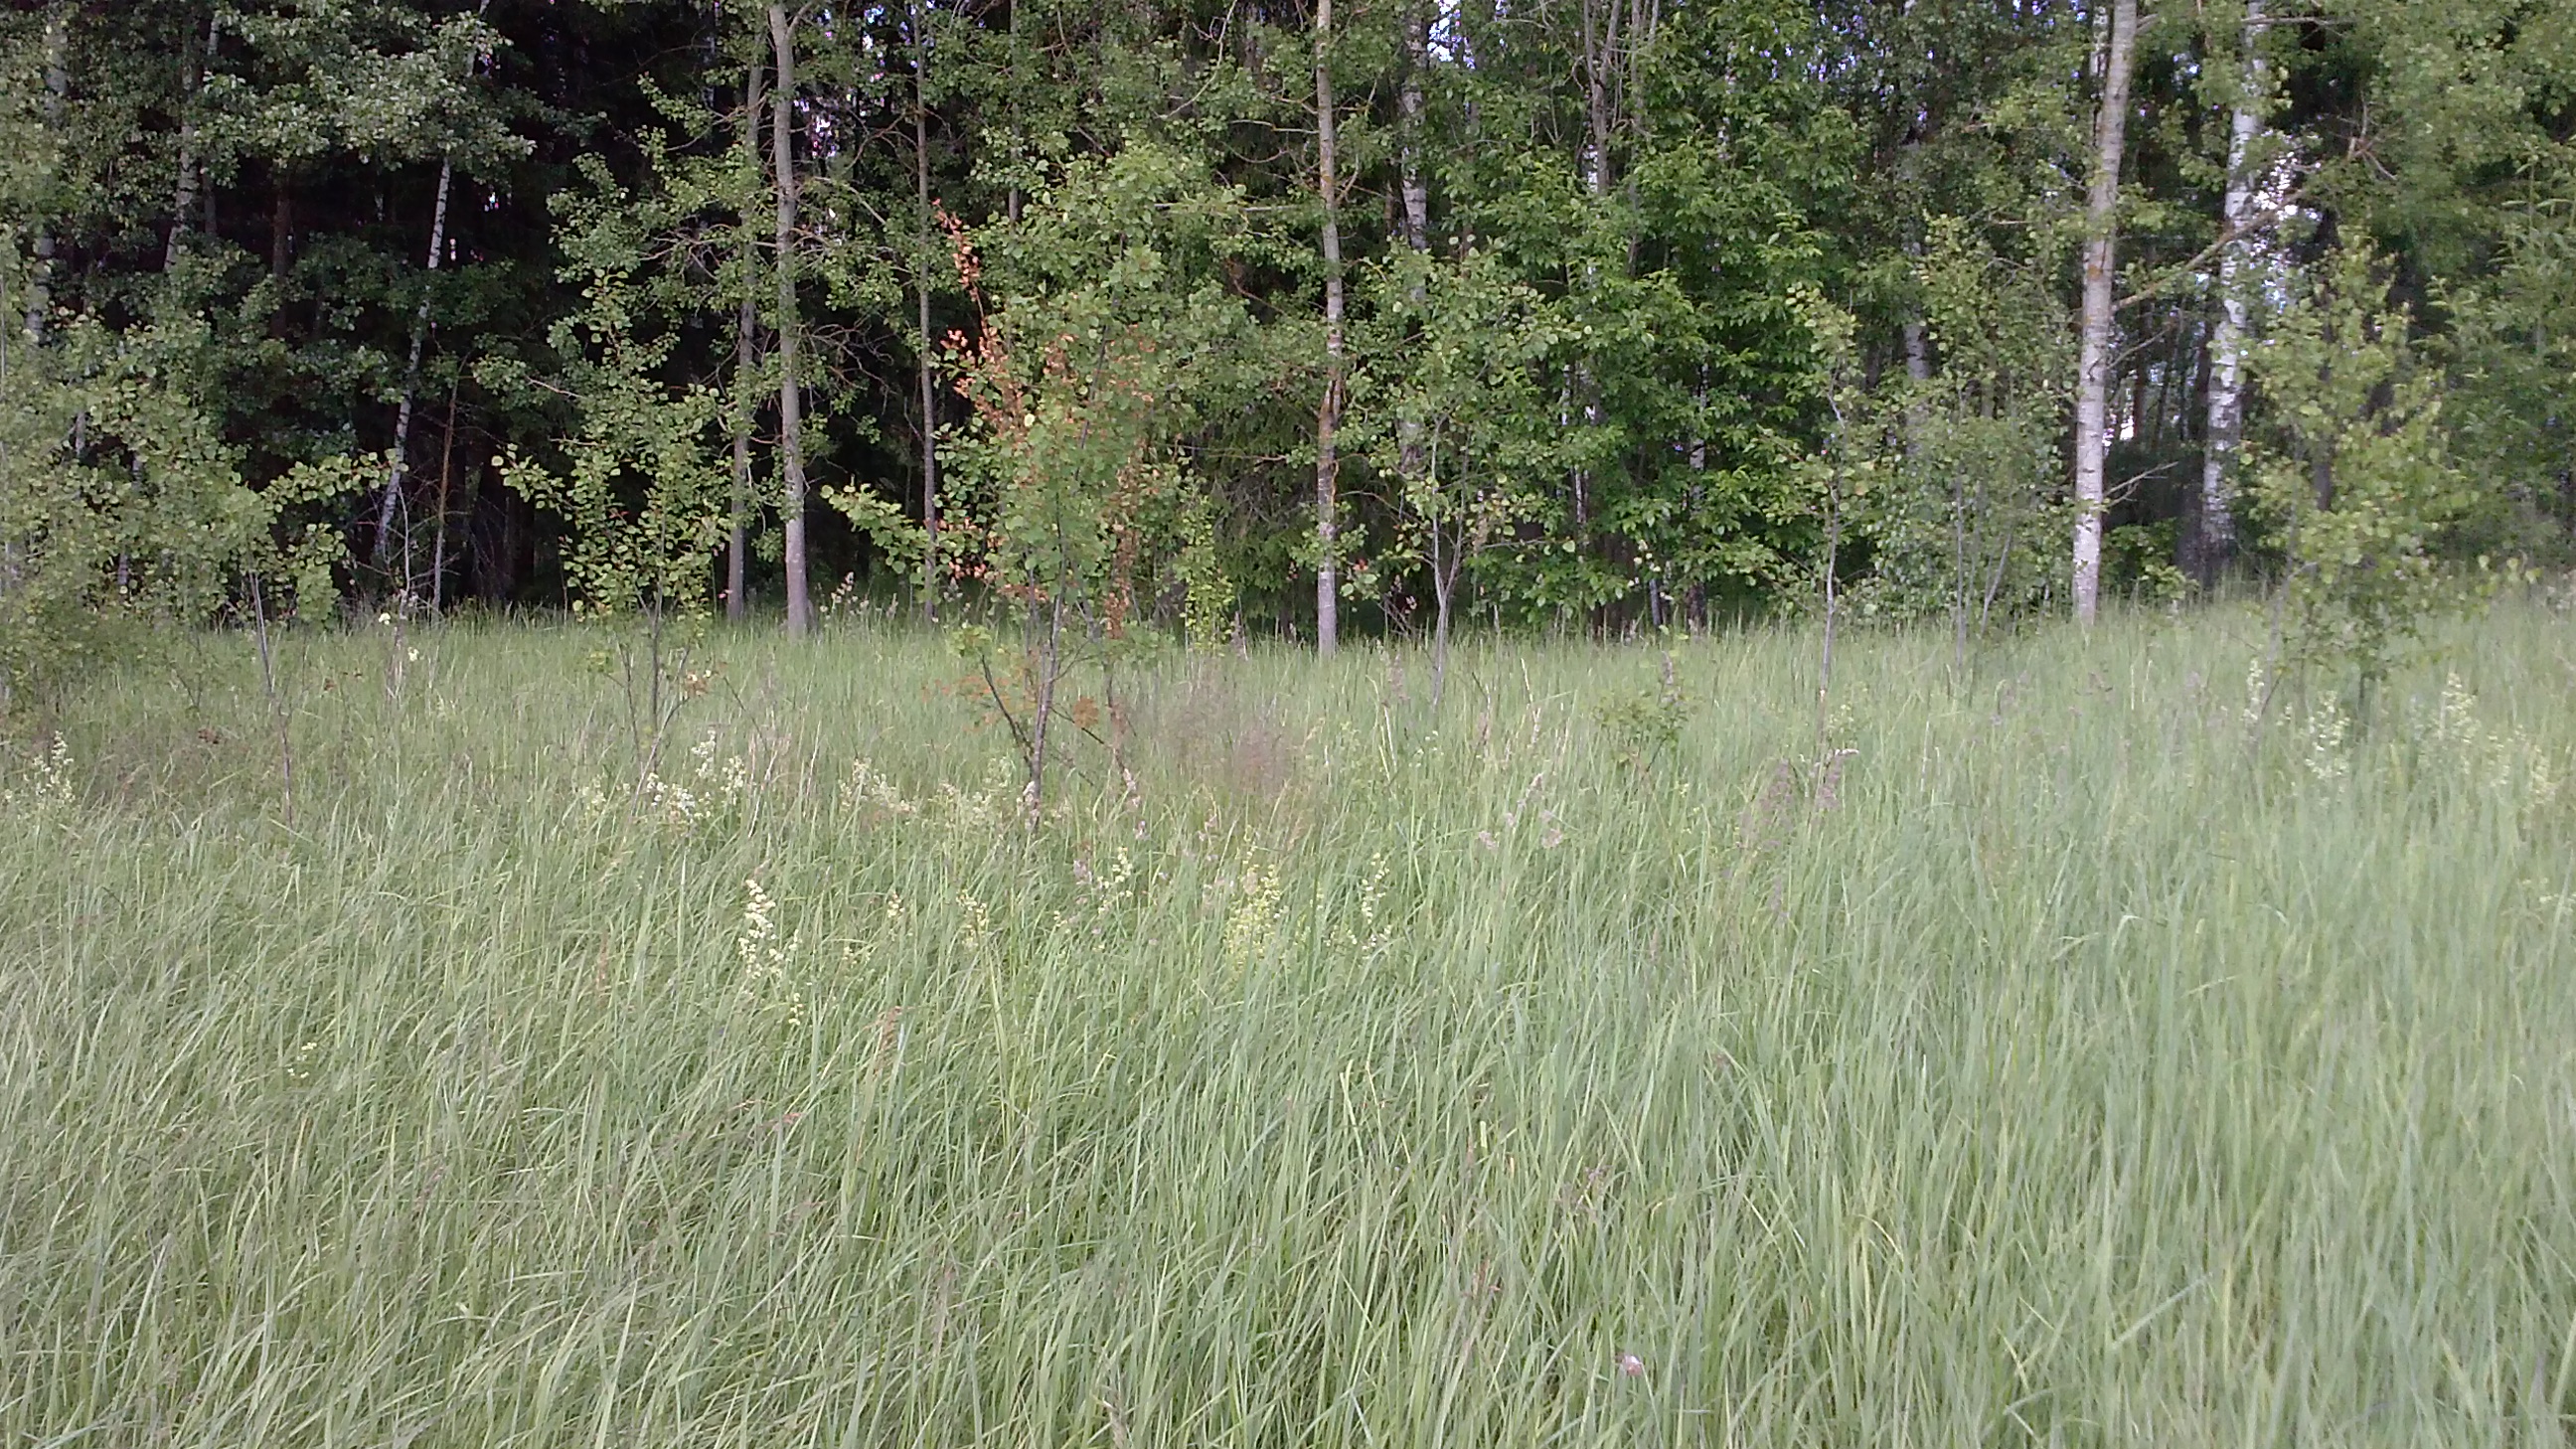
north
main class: Grassland
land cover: Grassland without tree/shrub cover
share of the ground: > 75 %
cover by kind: herbaceous plants 100 %
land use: Agriculture (excluding fallow land and kitchen gardens)
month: June
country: LV
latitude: 56.4825
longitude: 27.9088
